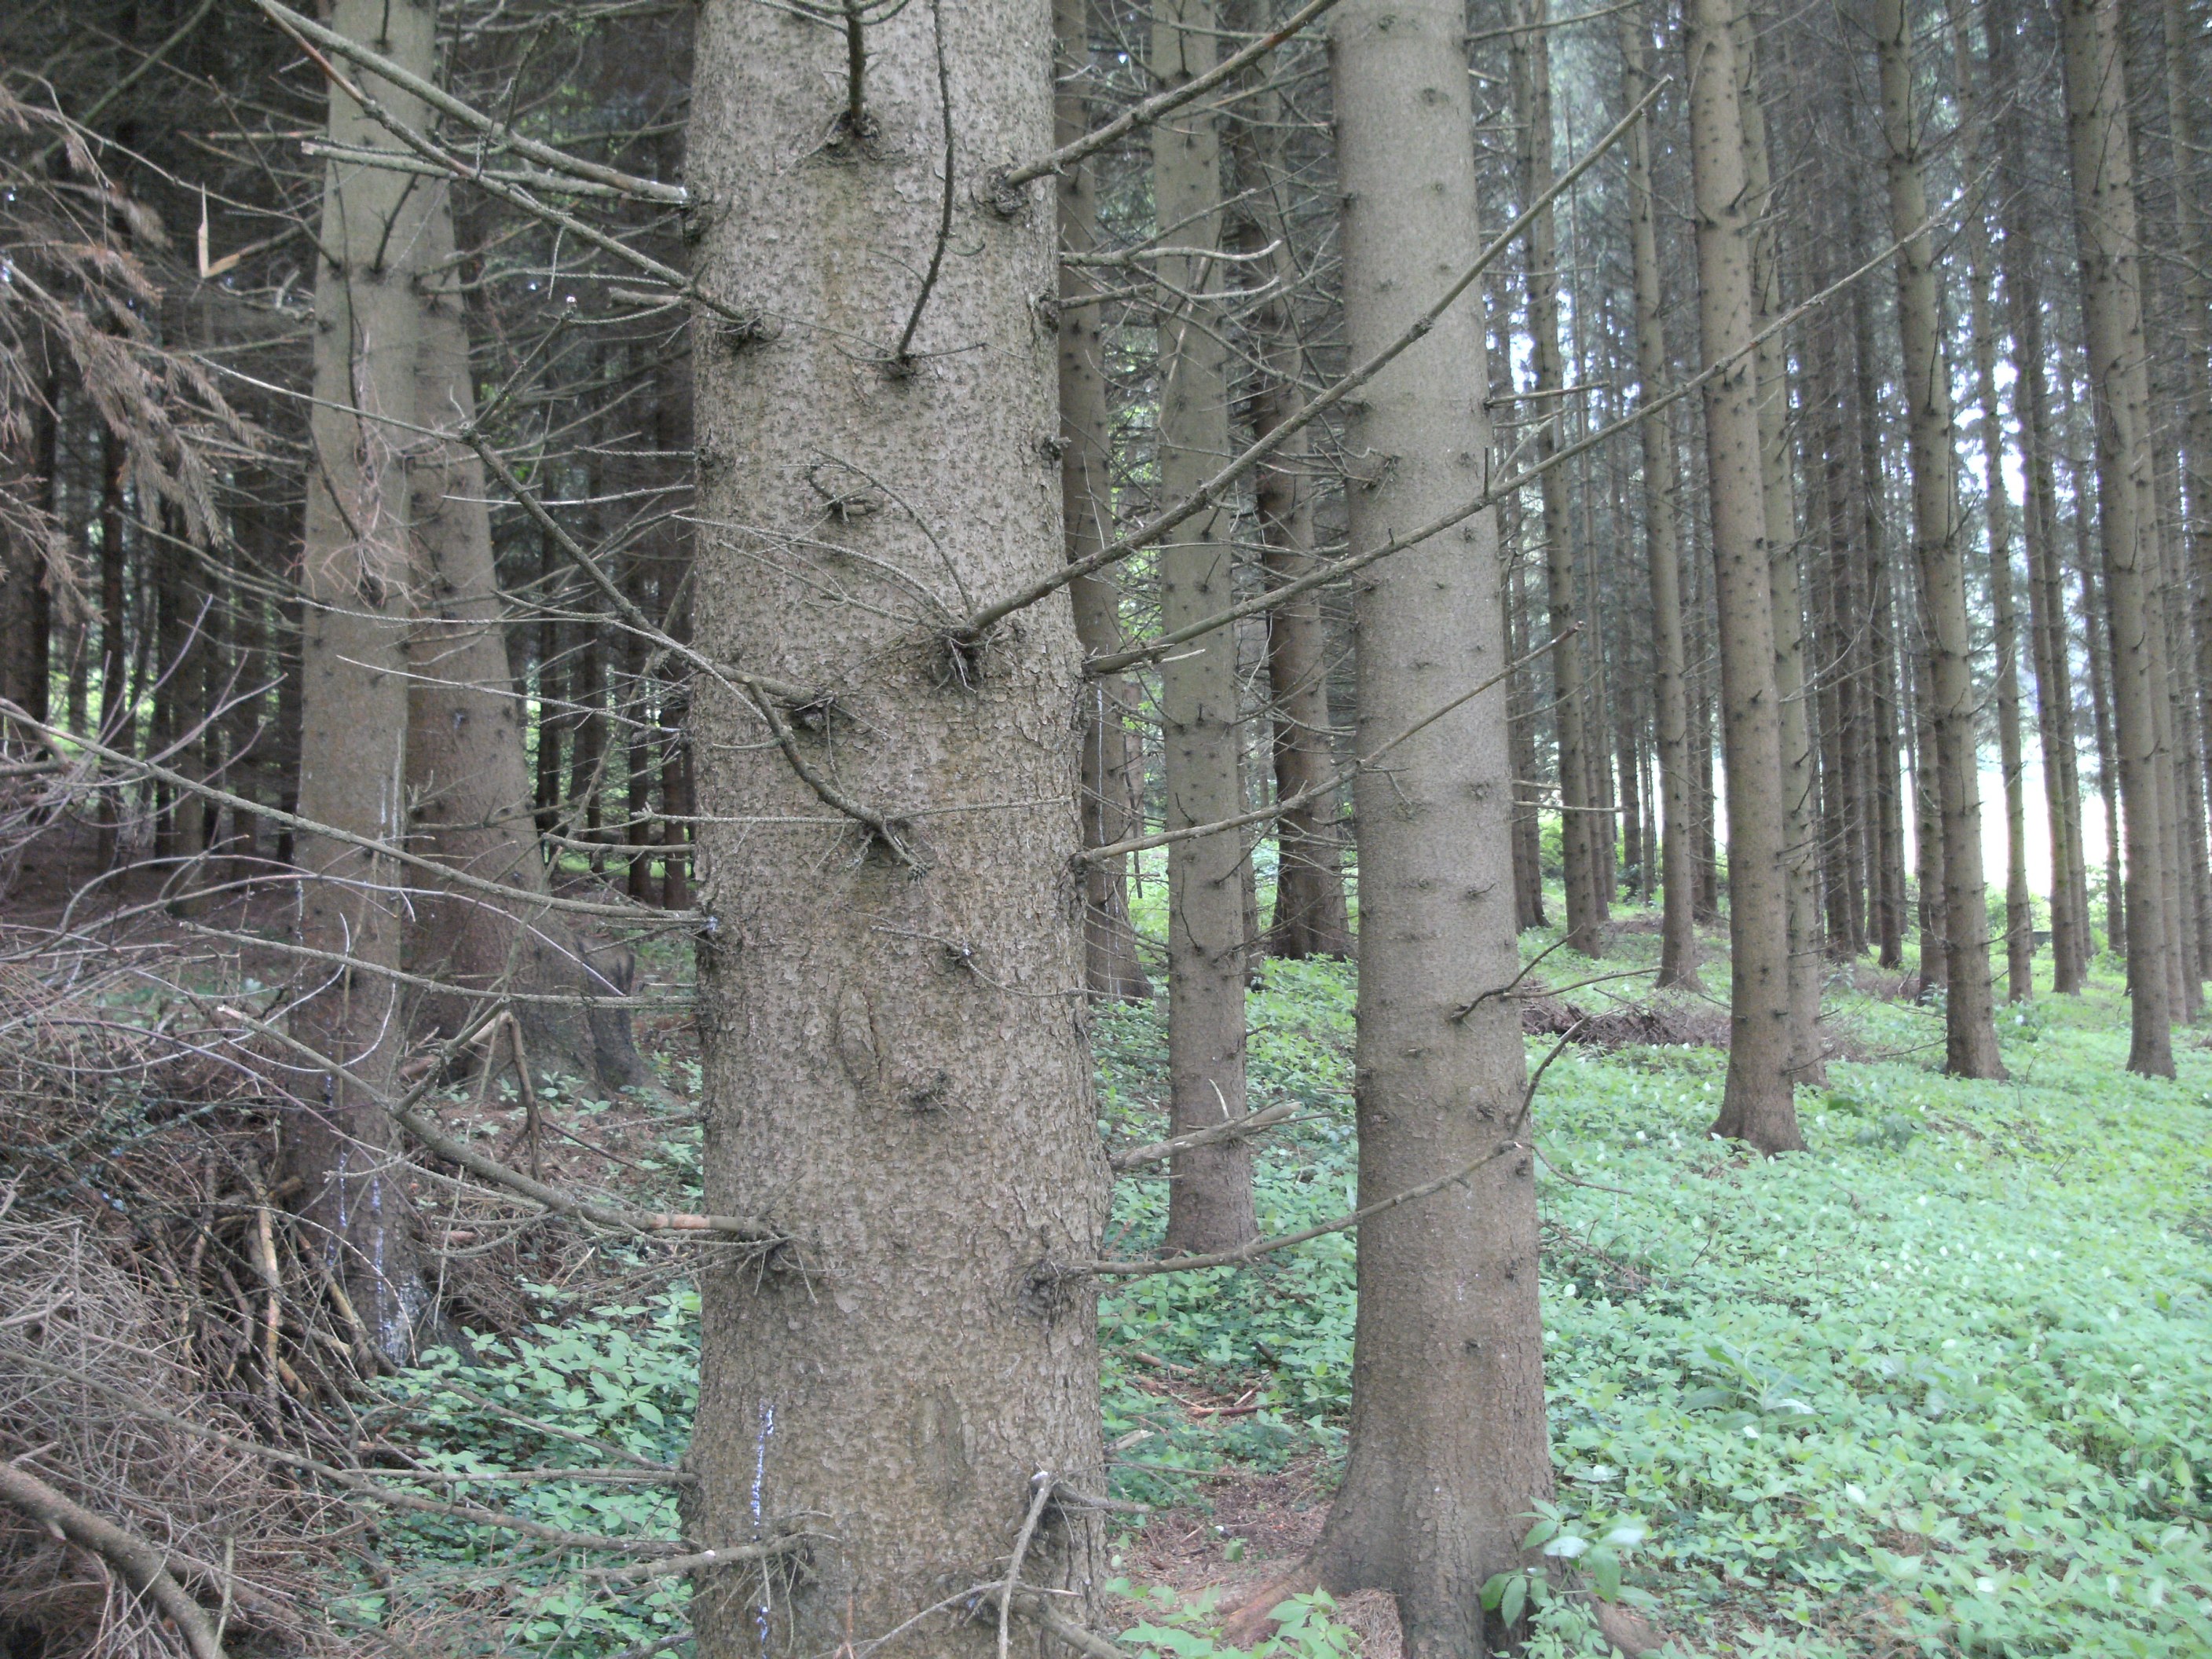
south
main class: Woodland
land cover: Spruce dominated coniferous woodland
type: hemiboreal forest and nemoral coniferous forest and mixed broadleaved-coniferous forest
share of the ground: > 75 %
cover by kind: coniferous forest trees 80 %, herbaceous plants 20 %
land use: Forestry
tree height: > 5 m
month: June
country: AT
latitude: 48.5174
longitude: 14.3192
